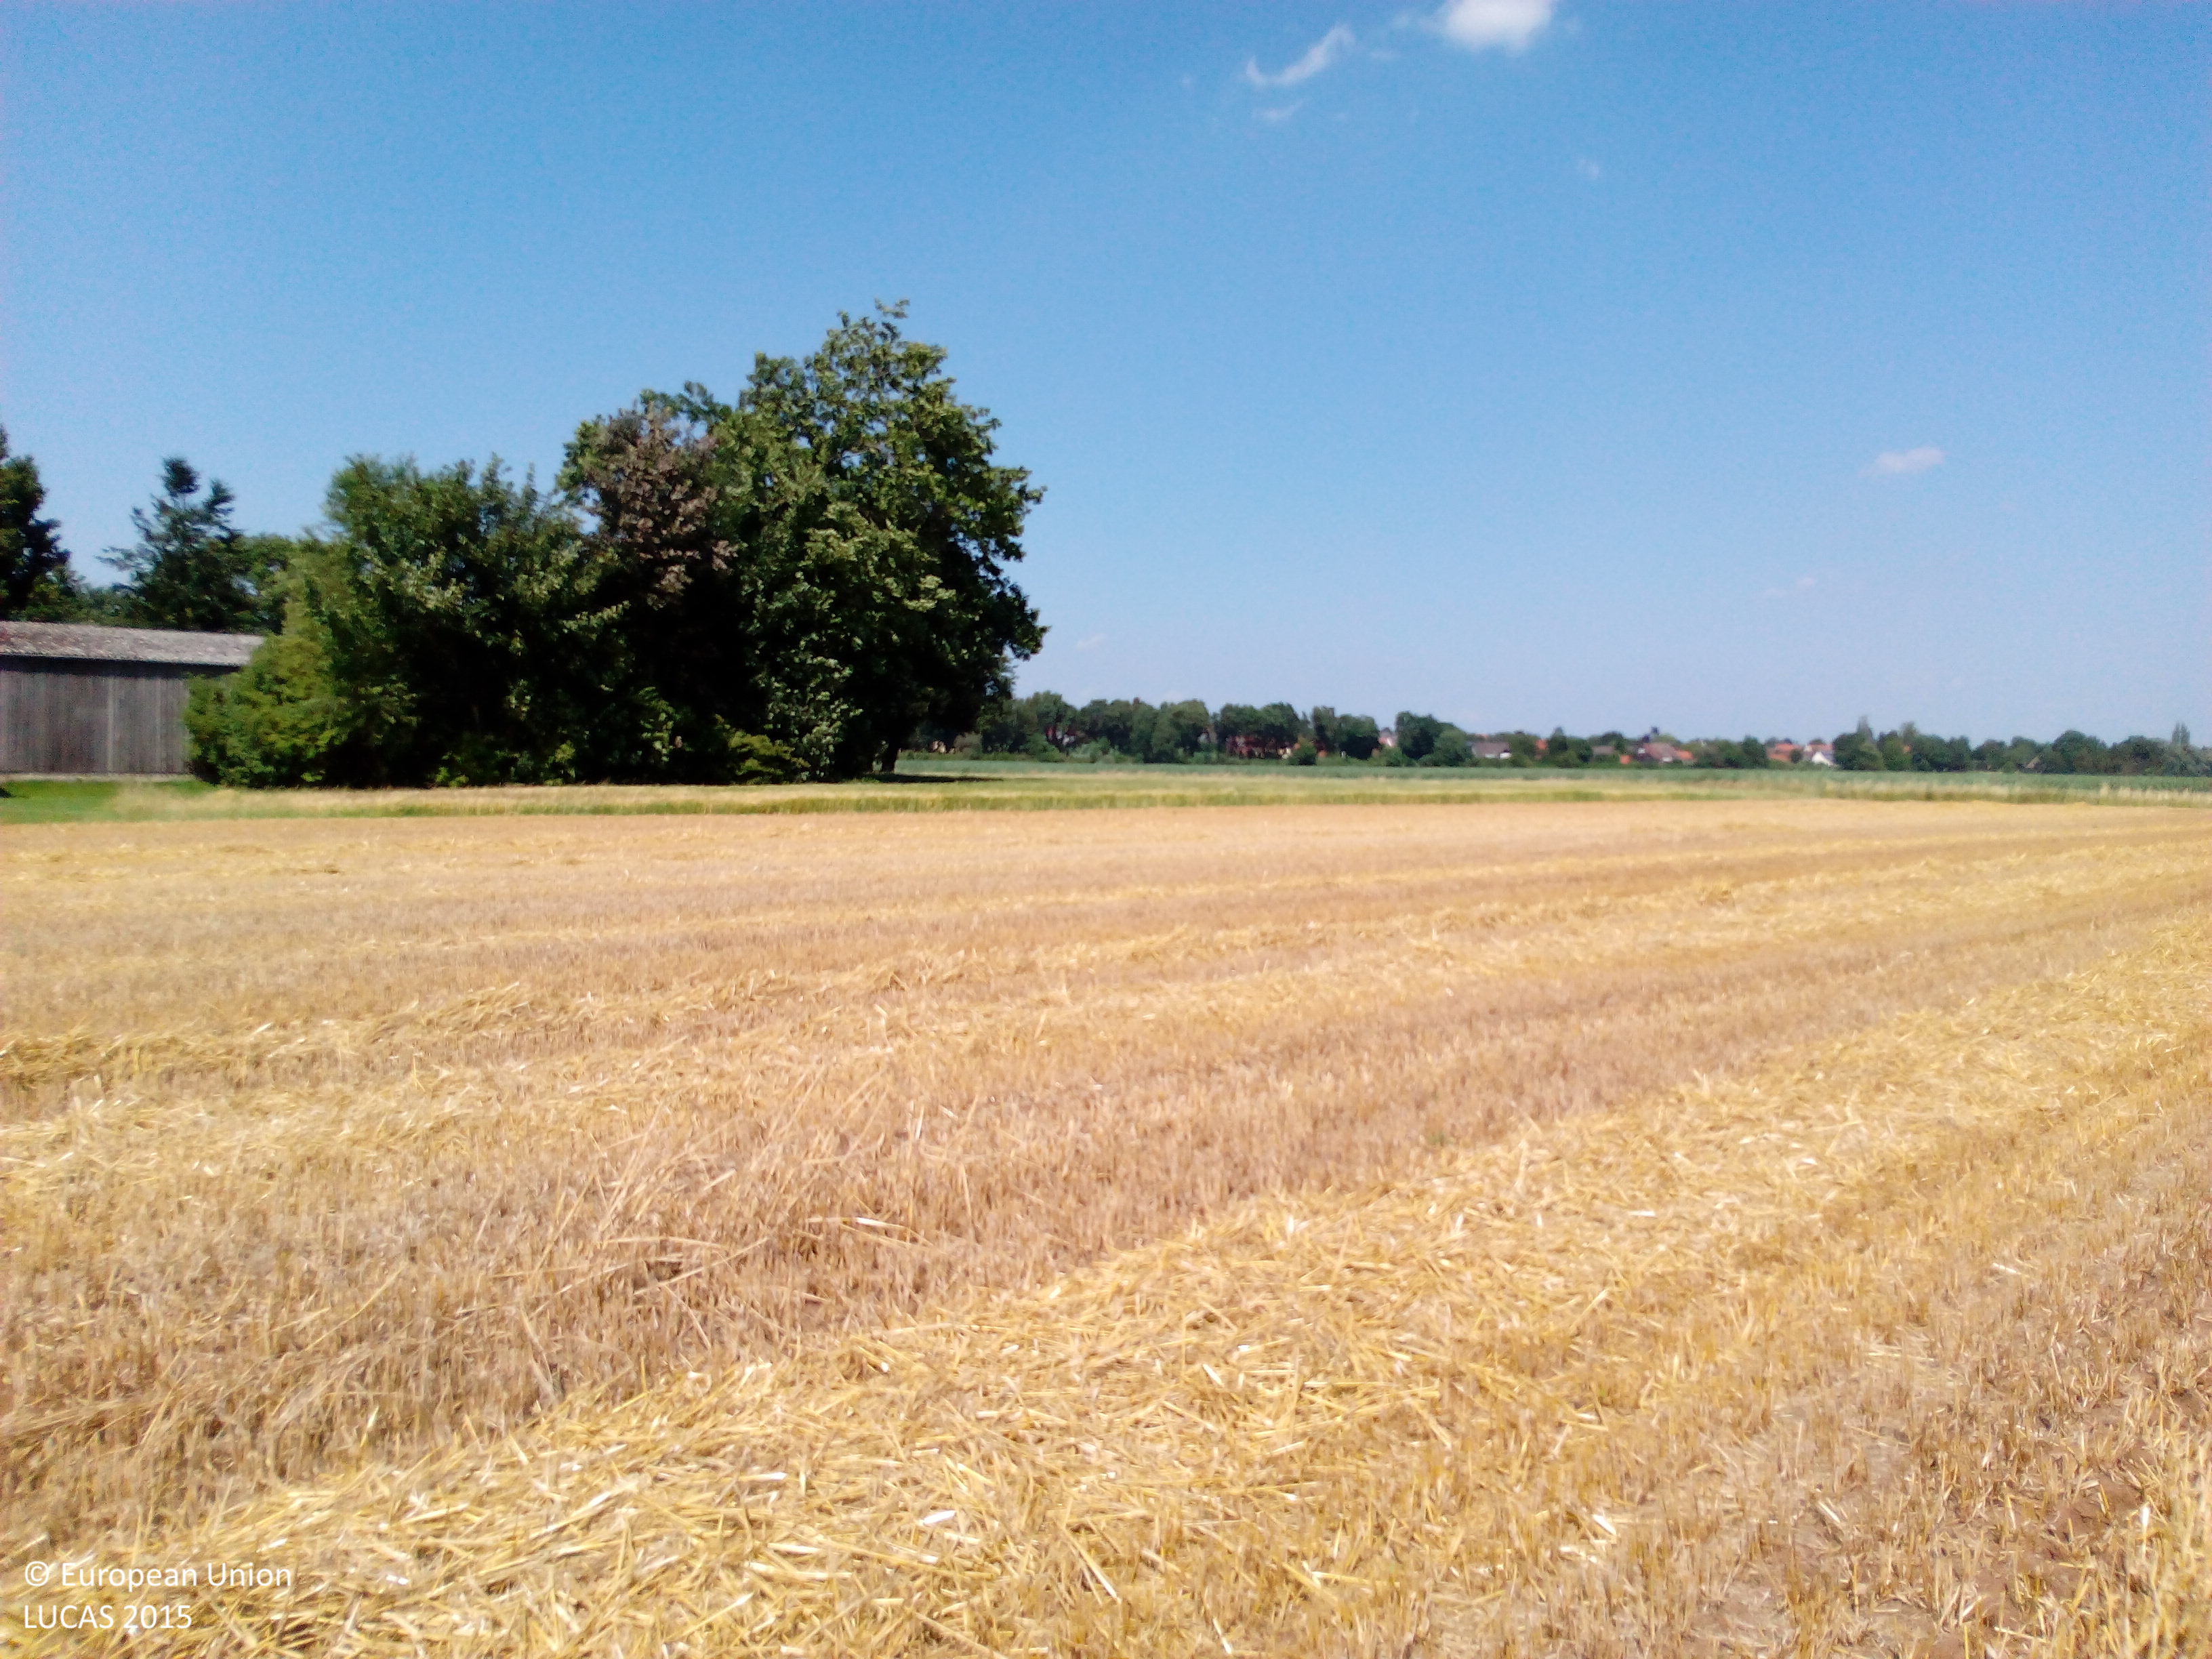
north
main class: Cropland
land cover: Barley
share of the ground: 50 - 75 %
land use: Agriculture (excluding fallow land and kitchen gardens)
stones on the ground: < 10 %
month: July
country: DE
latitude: 52.3959
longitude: 7.9577
